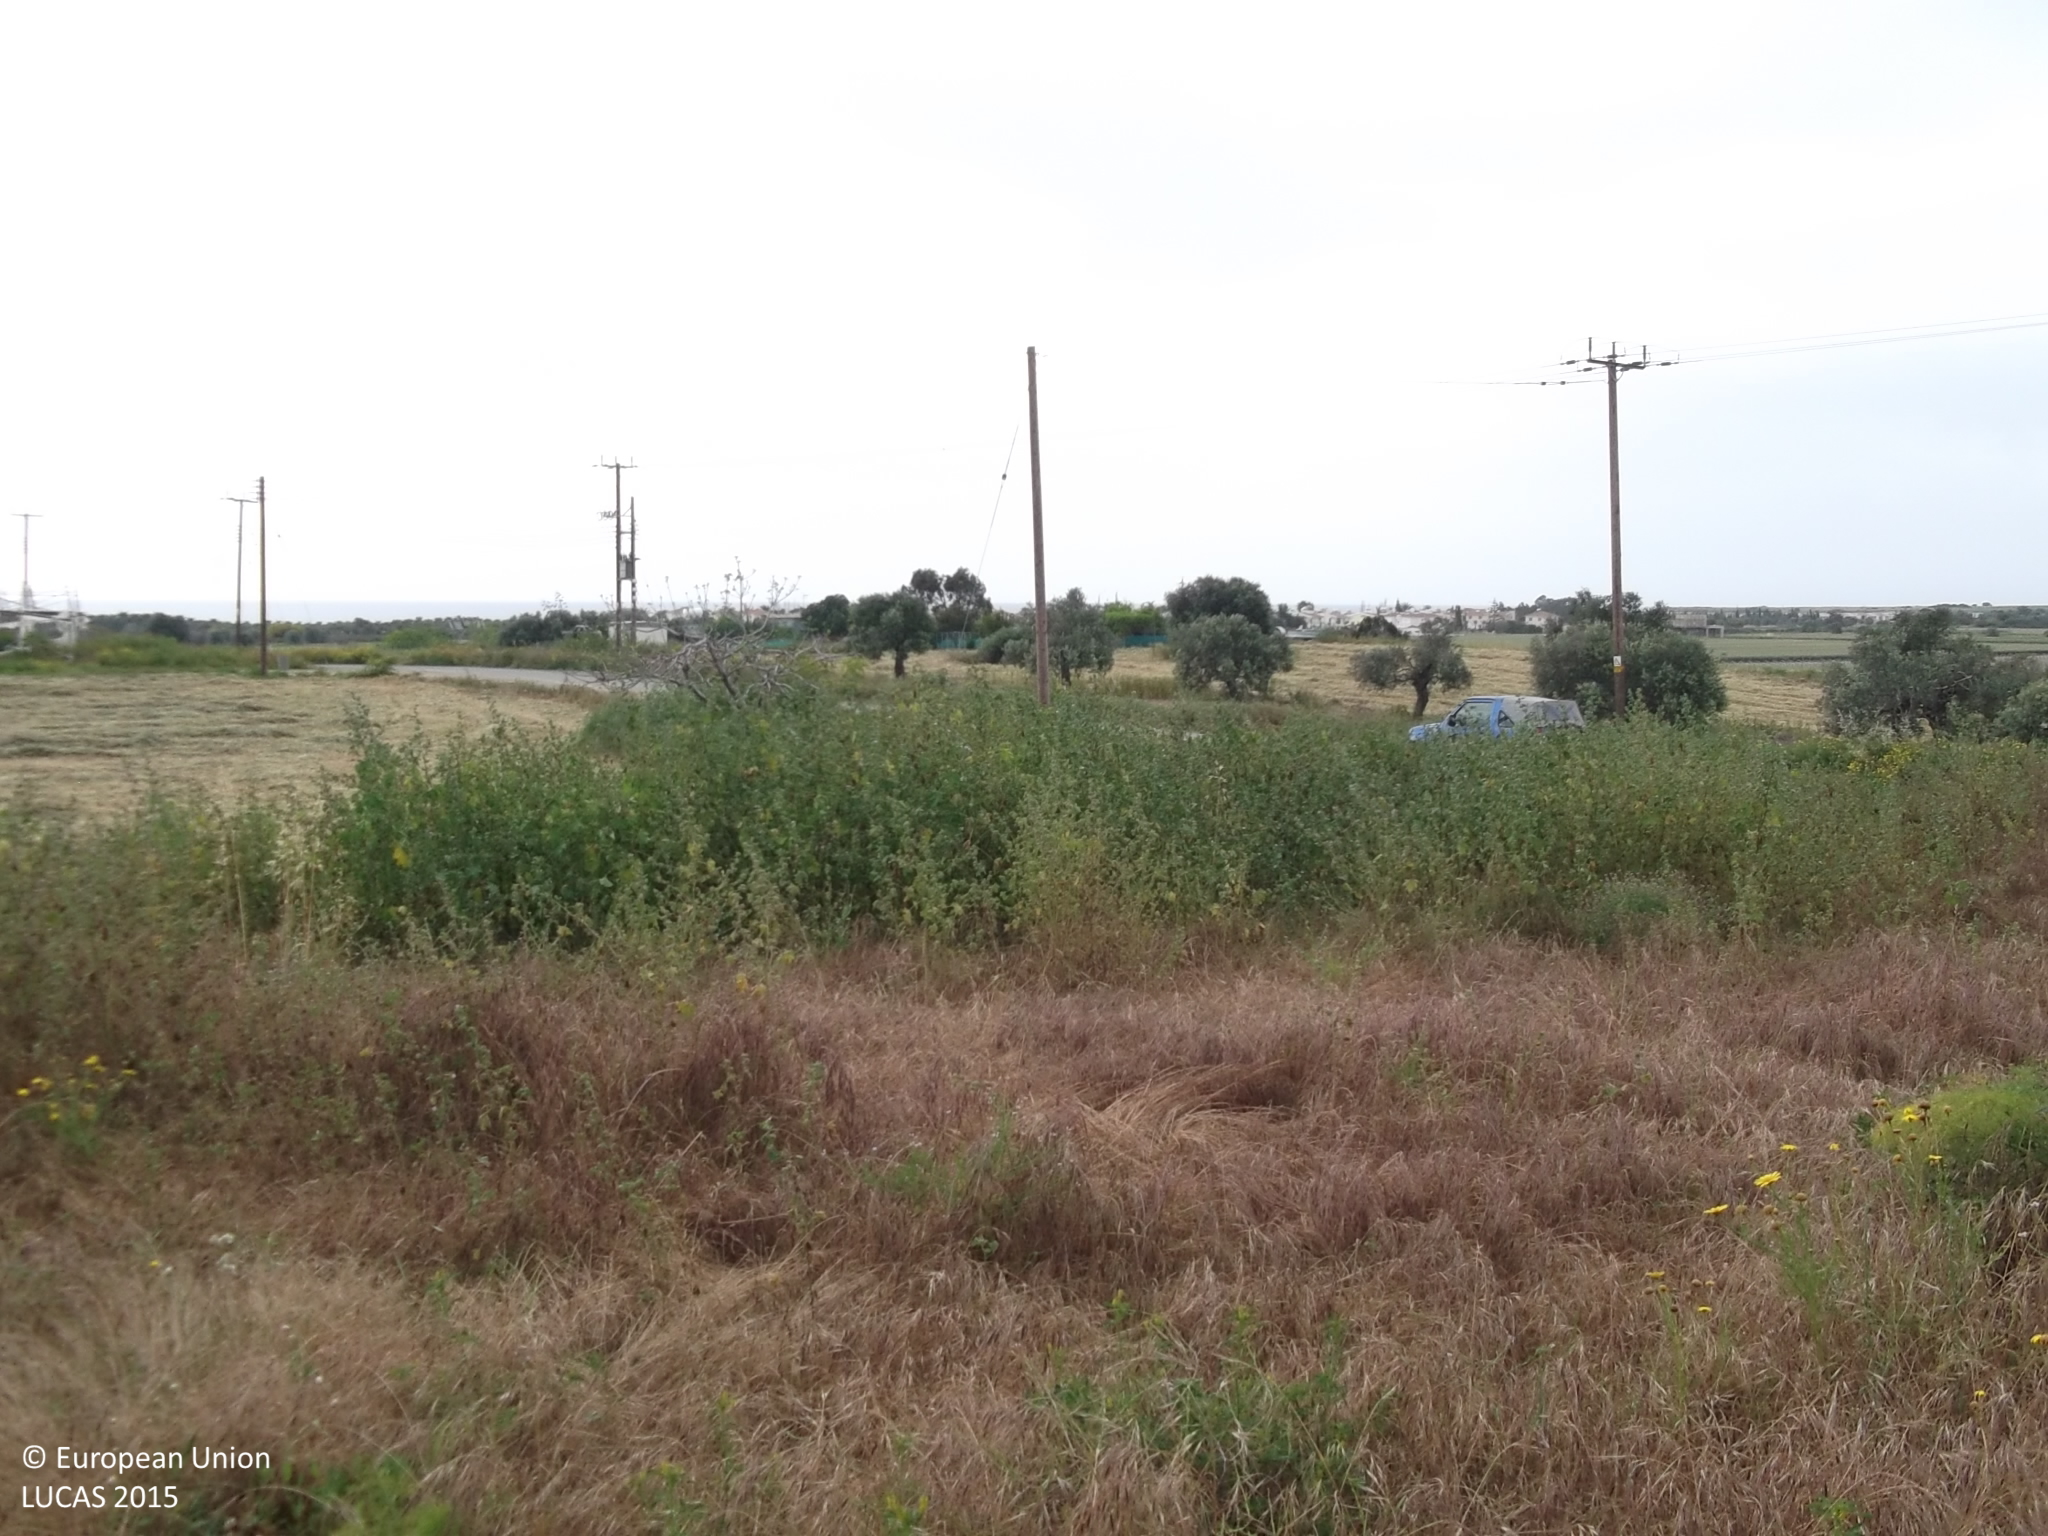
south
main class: Grassland
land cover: Grassland without tree/shrub cover
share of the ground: > 75 %
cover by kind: herbaceous plants 100 %
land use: Abandoned areas
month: April
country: CY
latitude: 34.7960
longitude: 33.5000
